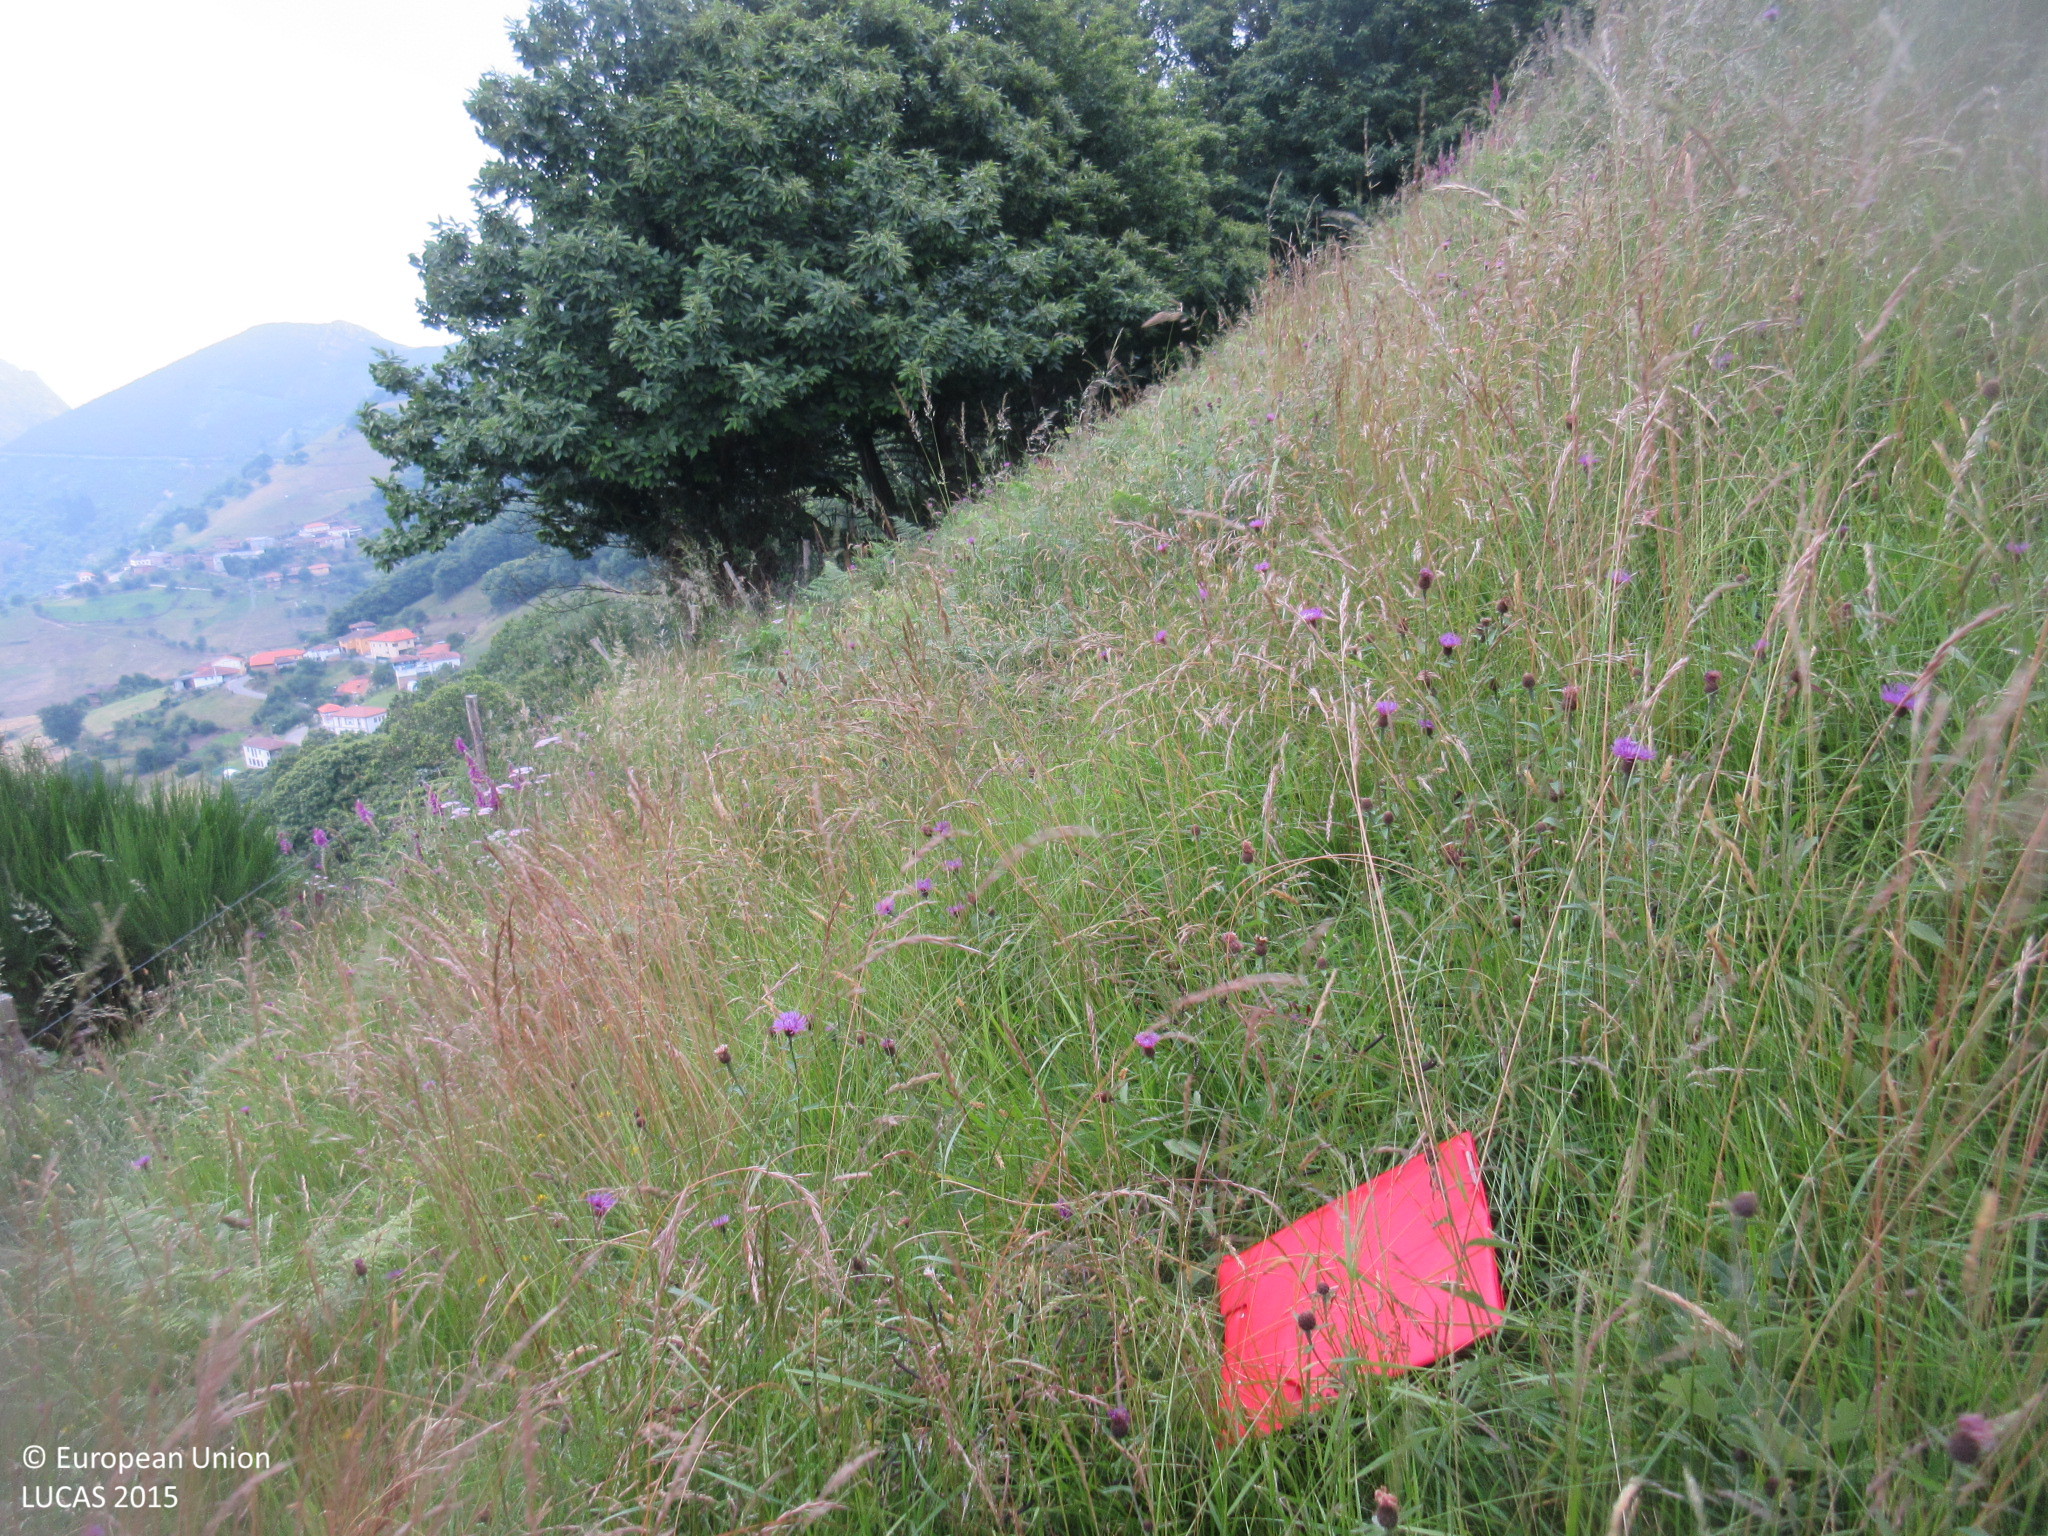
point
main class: Grassland
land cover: Grassland without tree/shrub cover
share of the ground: > 75 %
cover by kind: herbaceous plants 100 %
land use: Agriculture (excluding fallow land and kitchen gardens)
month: June
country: ES
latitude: 43.2815
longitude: -6.3527
